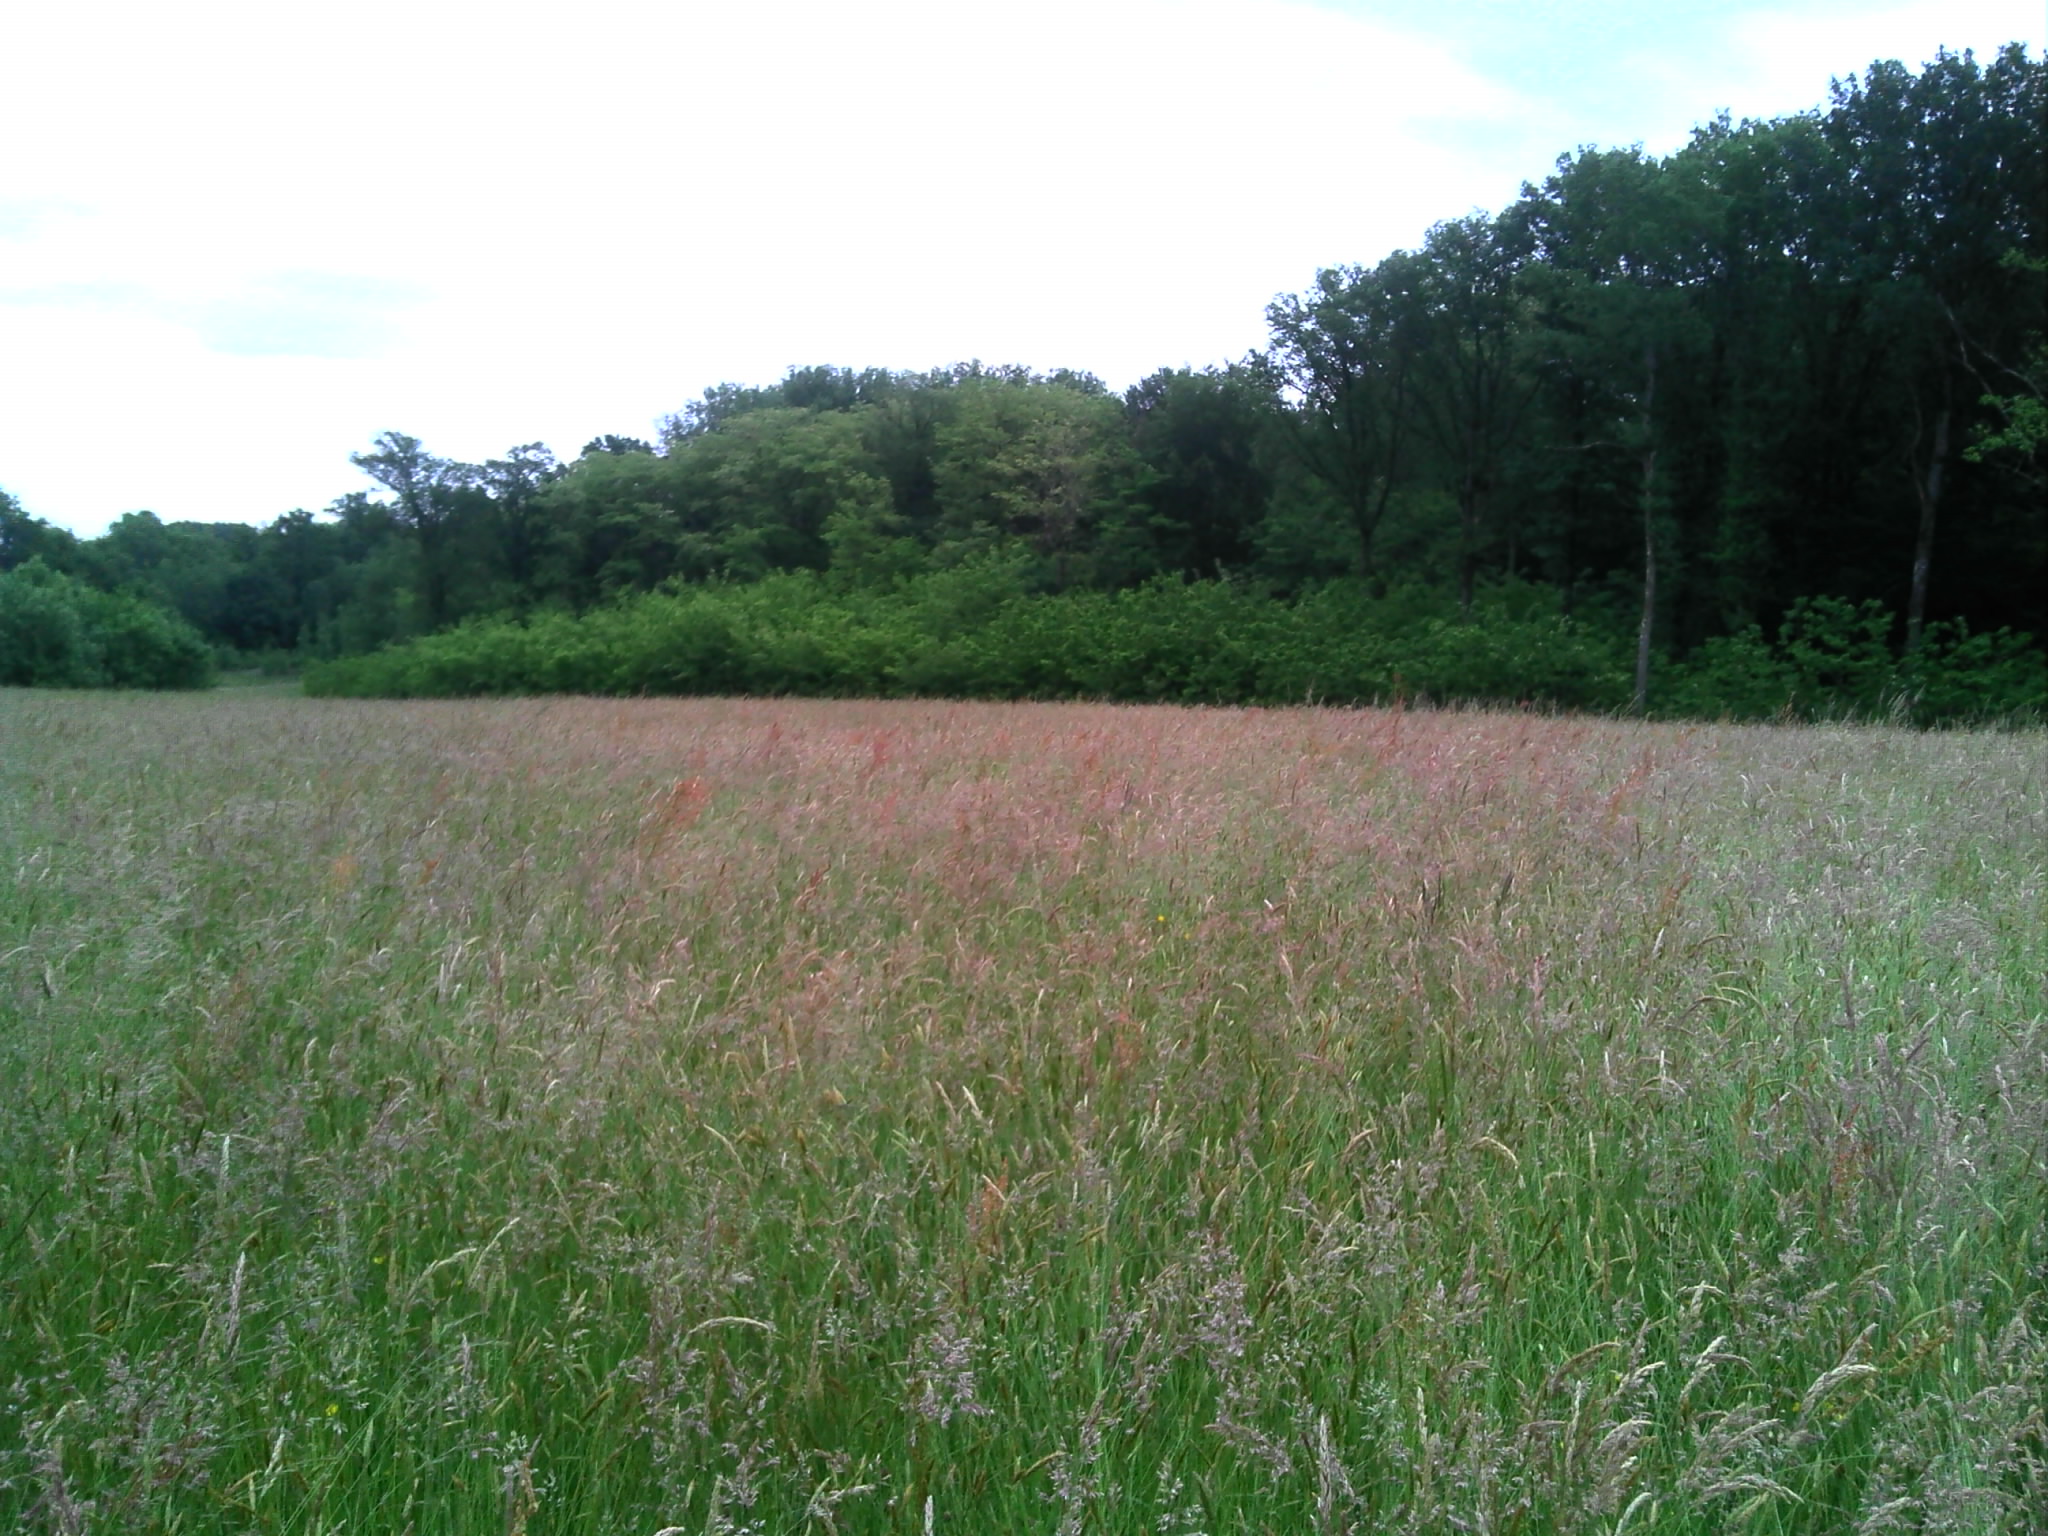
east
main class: Grassland
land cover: Grassland without tree/shrub cover
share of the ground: > 75 %
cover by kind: herbaceous plants 100 %
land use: Agriculture (excluding fallow land and kitchen gardens)
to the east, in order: Grassland without tree/shrub cover; Ditches and canals; Broadleaved woodland
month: May
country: FR
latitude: 46.5735
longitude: 5.3182
